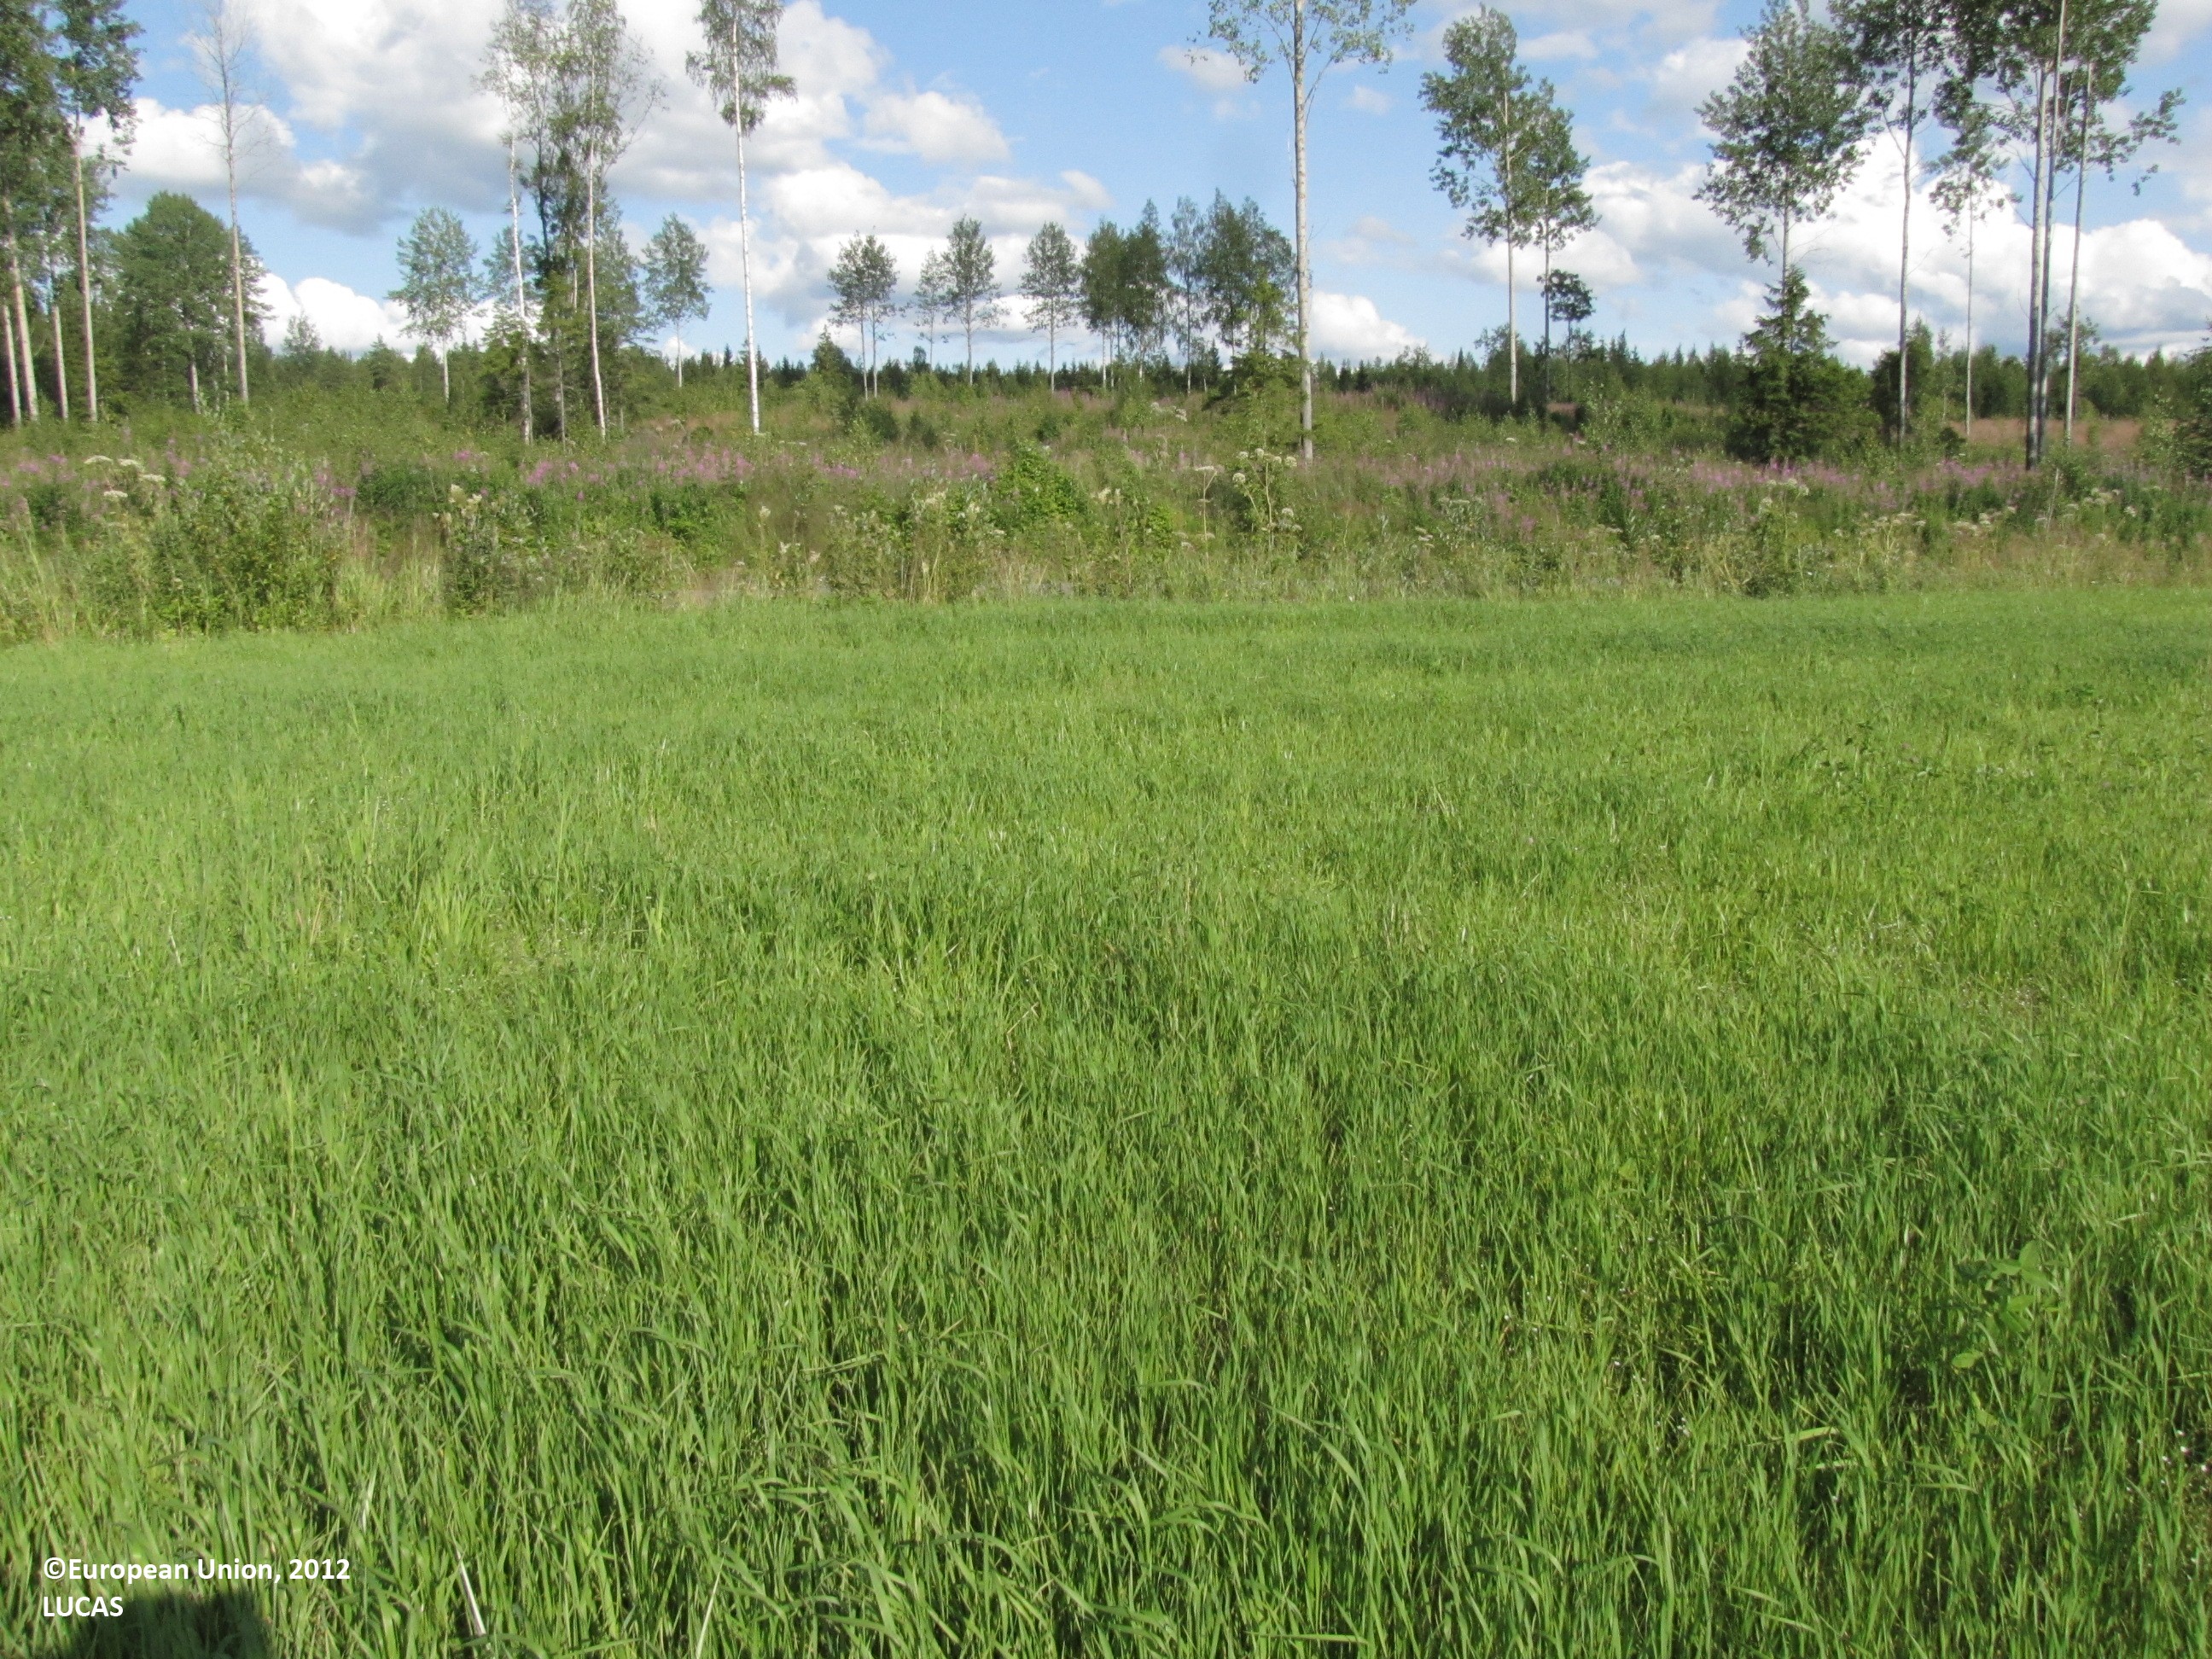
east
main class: Cropland
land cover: Temporary grasslands
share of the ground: > 75 %
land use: Agriculture (excluding fallow land and kitchen gardens)
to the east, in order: Temporary grasslands; Grass margins; Ditches and canals; Grass margins; Paved roads, cycling and walking lanes; Ditches and canals; Broadleaved woodland; Spruce dominated coniferous woodland; Ditches and canals; Spruce dominated coniferous woodland; Broadleaved woodland; Spruce dominated coniferous woodland; Ditches and canals; Spruce dominated coniferous woodland; Broadleaved woodland; Spruce dominated coniferous woodland; Ditches and canals; Spruce dominated coniferous woodland; Broadleaved woodland; Spruce dominated coniferous woodland; Ditches and canals; Other mixed woodland
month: July
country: FI
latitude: 62.1296
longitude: 23.0875
